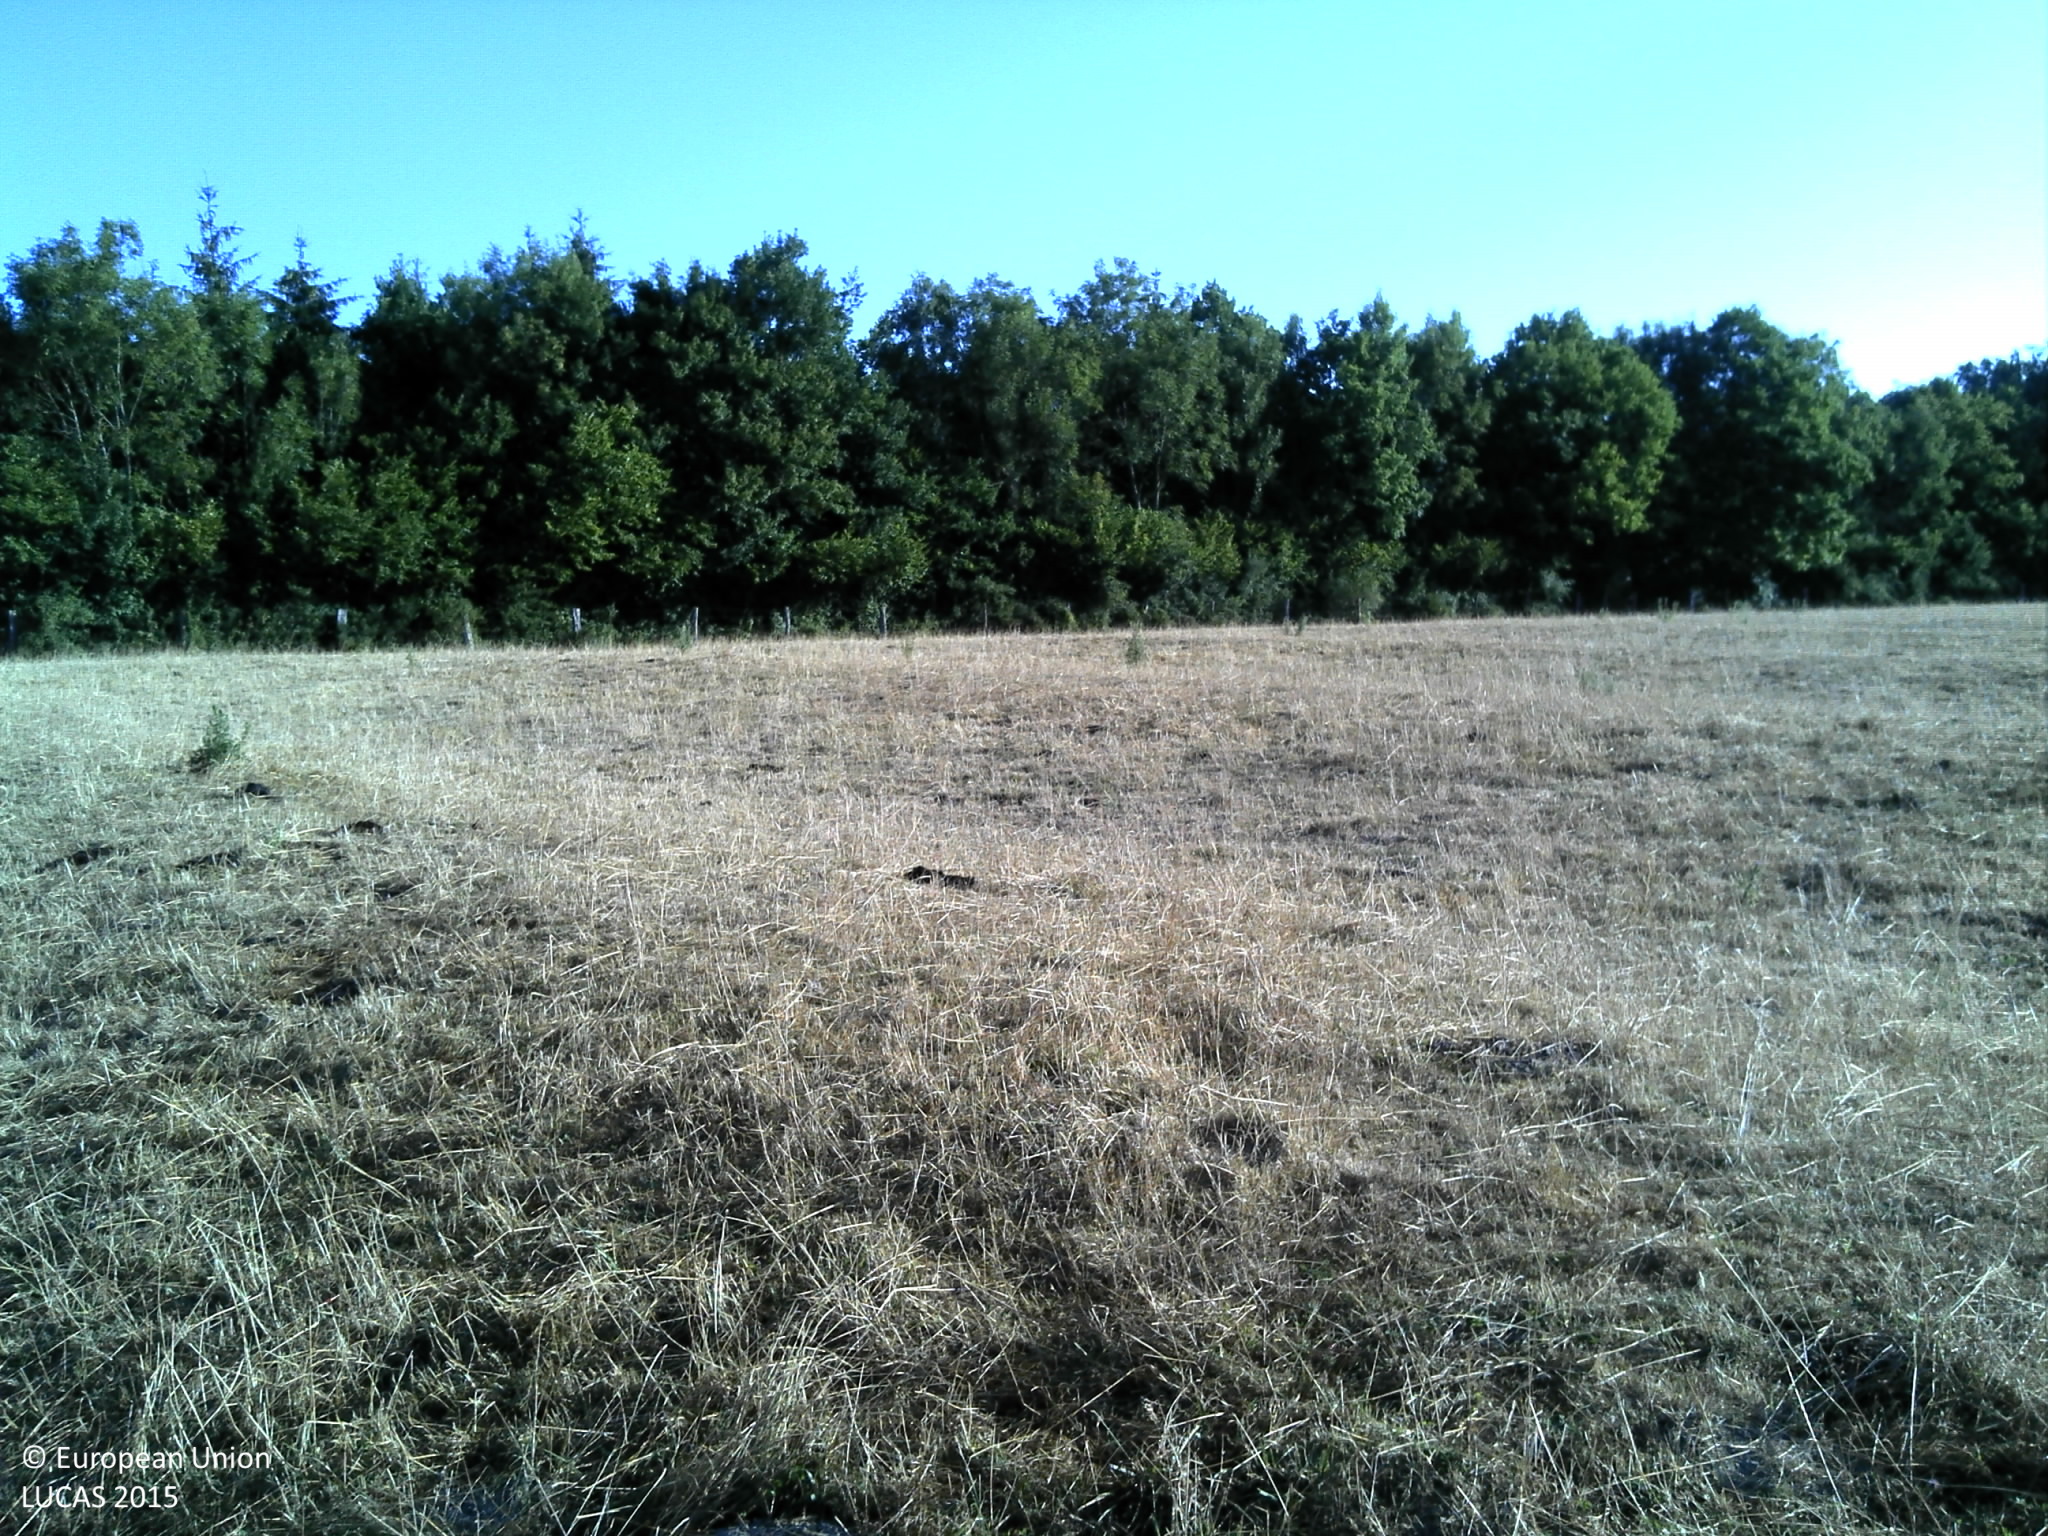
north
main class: Grassland
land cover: Grassland without tree/shrub cover
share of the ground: > 75 %
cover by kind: herbaceous plants 100 %
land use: Agriculture (excluding fallow land and kitchen gardens)
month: July
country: FR
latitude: 48.2279
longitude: 6.1369
